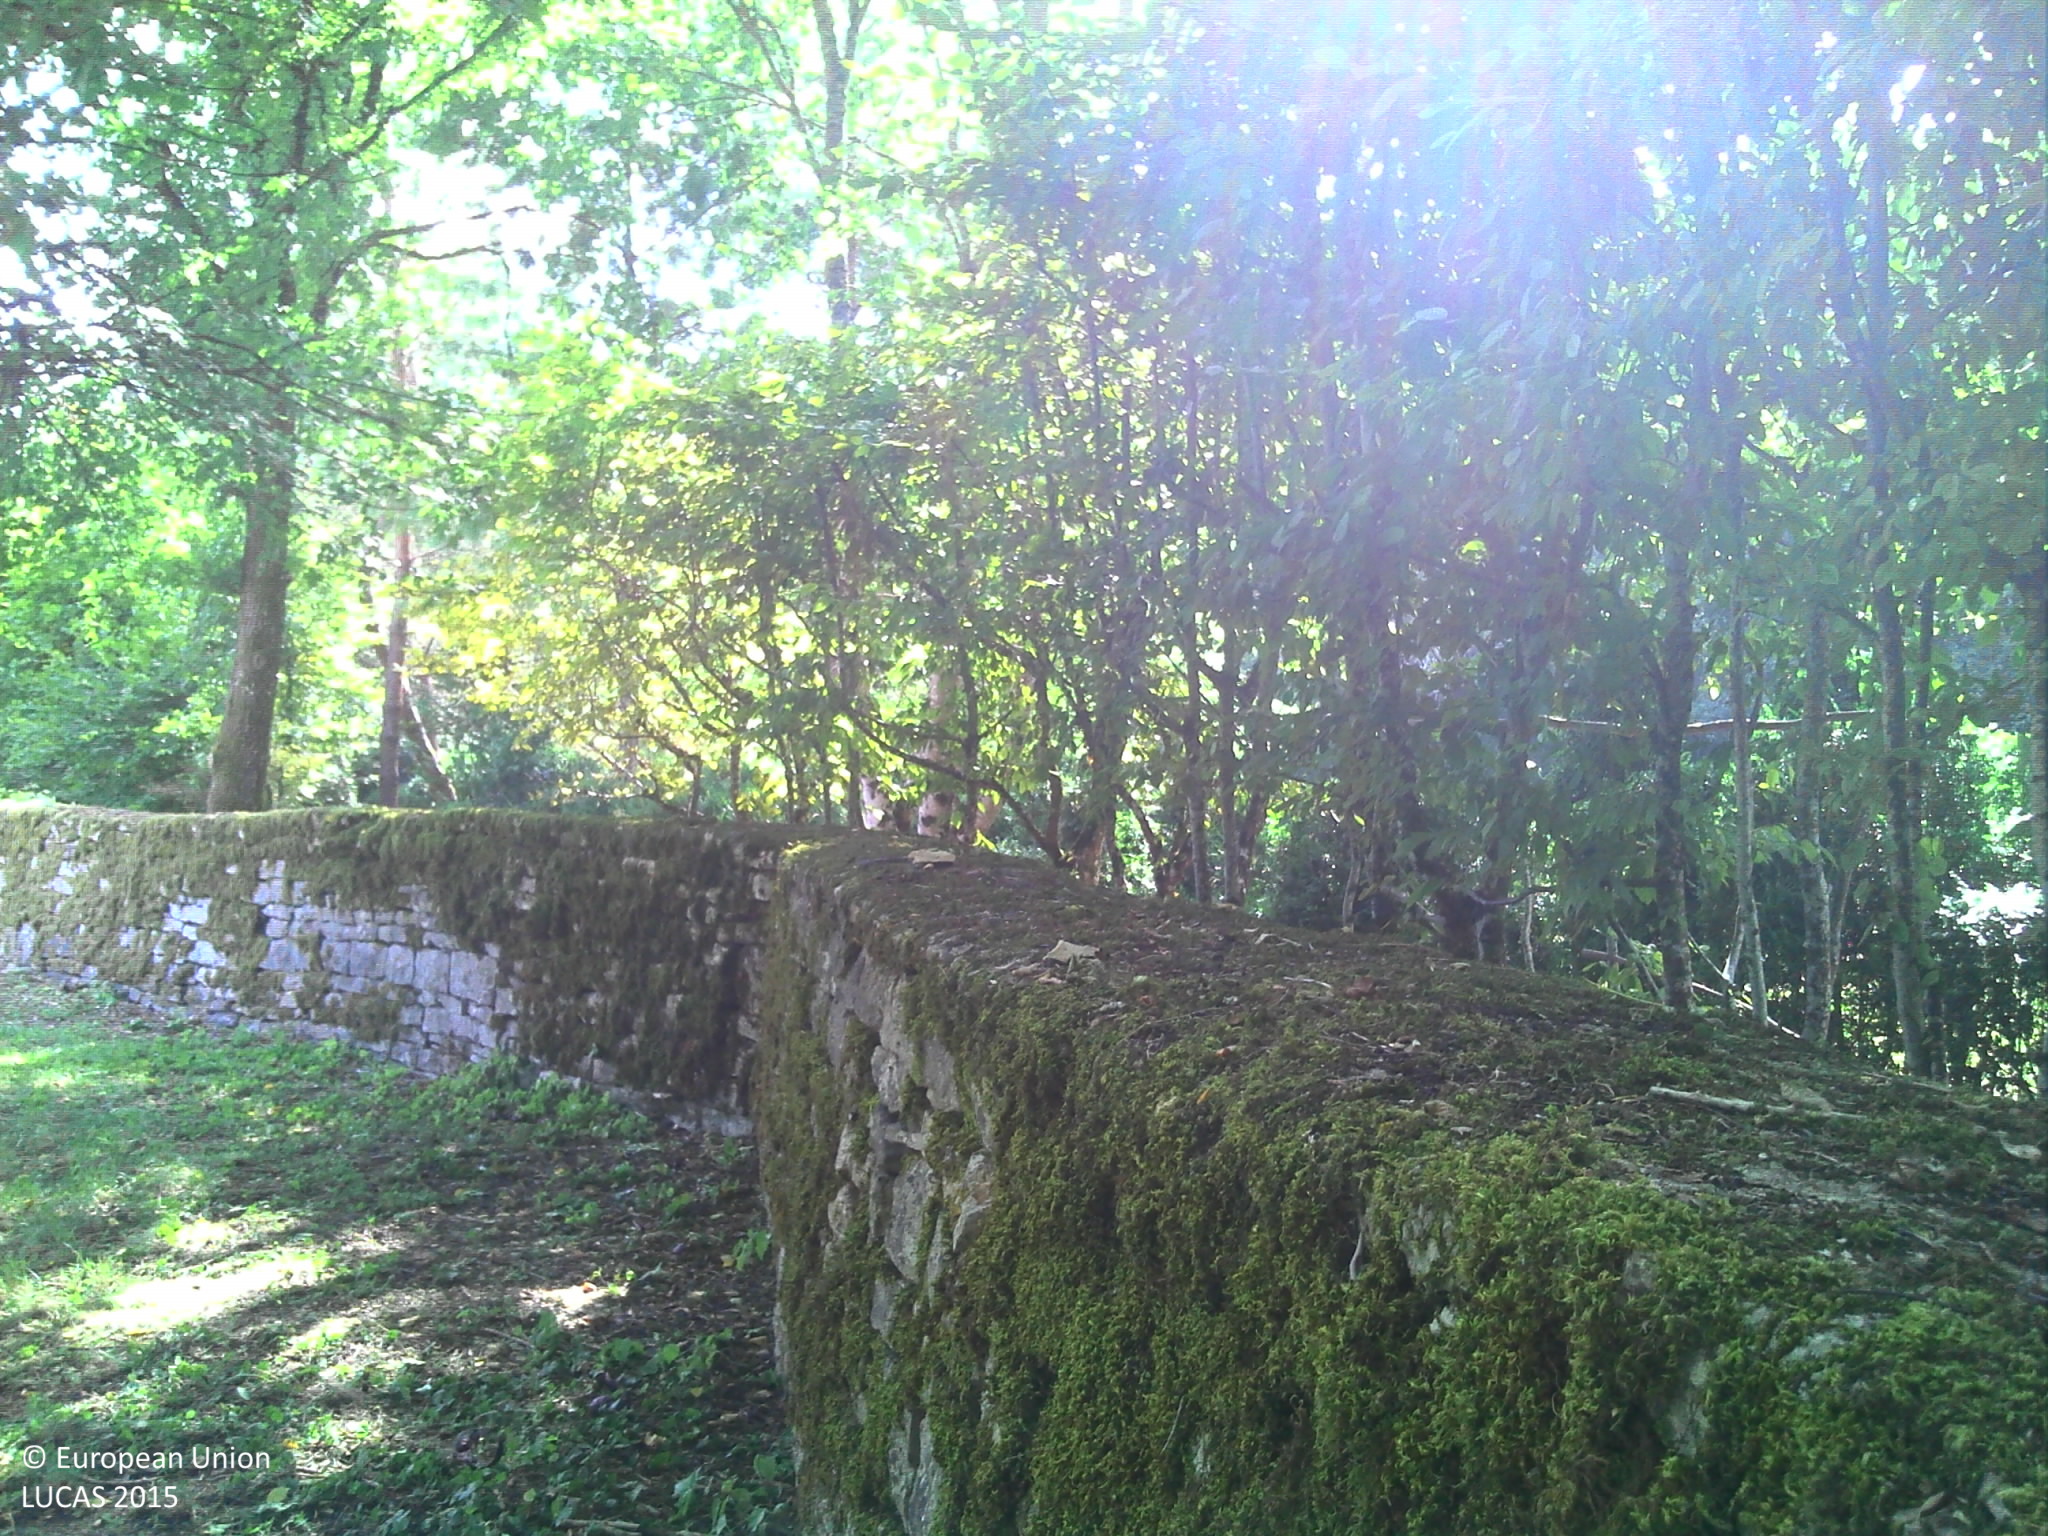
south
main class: Grassland
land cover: Grassland without tree/shrub cover
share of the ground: > 75 %
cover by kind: herbaceous plants 100 %
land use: Agriculture (excluding fallow land and kitchen gardens)
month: August
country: FR
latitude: 47.2510
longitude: 4.7546
